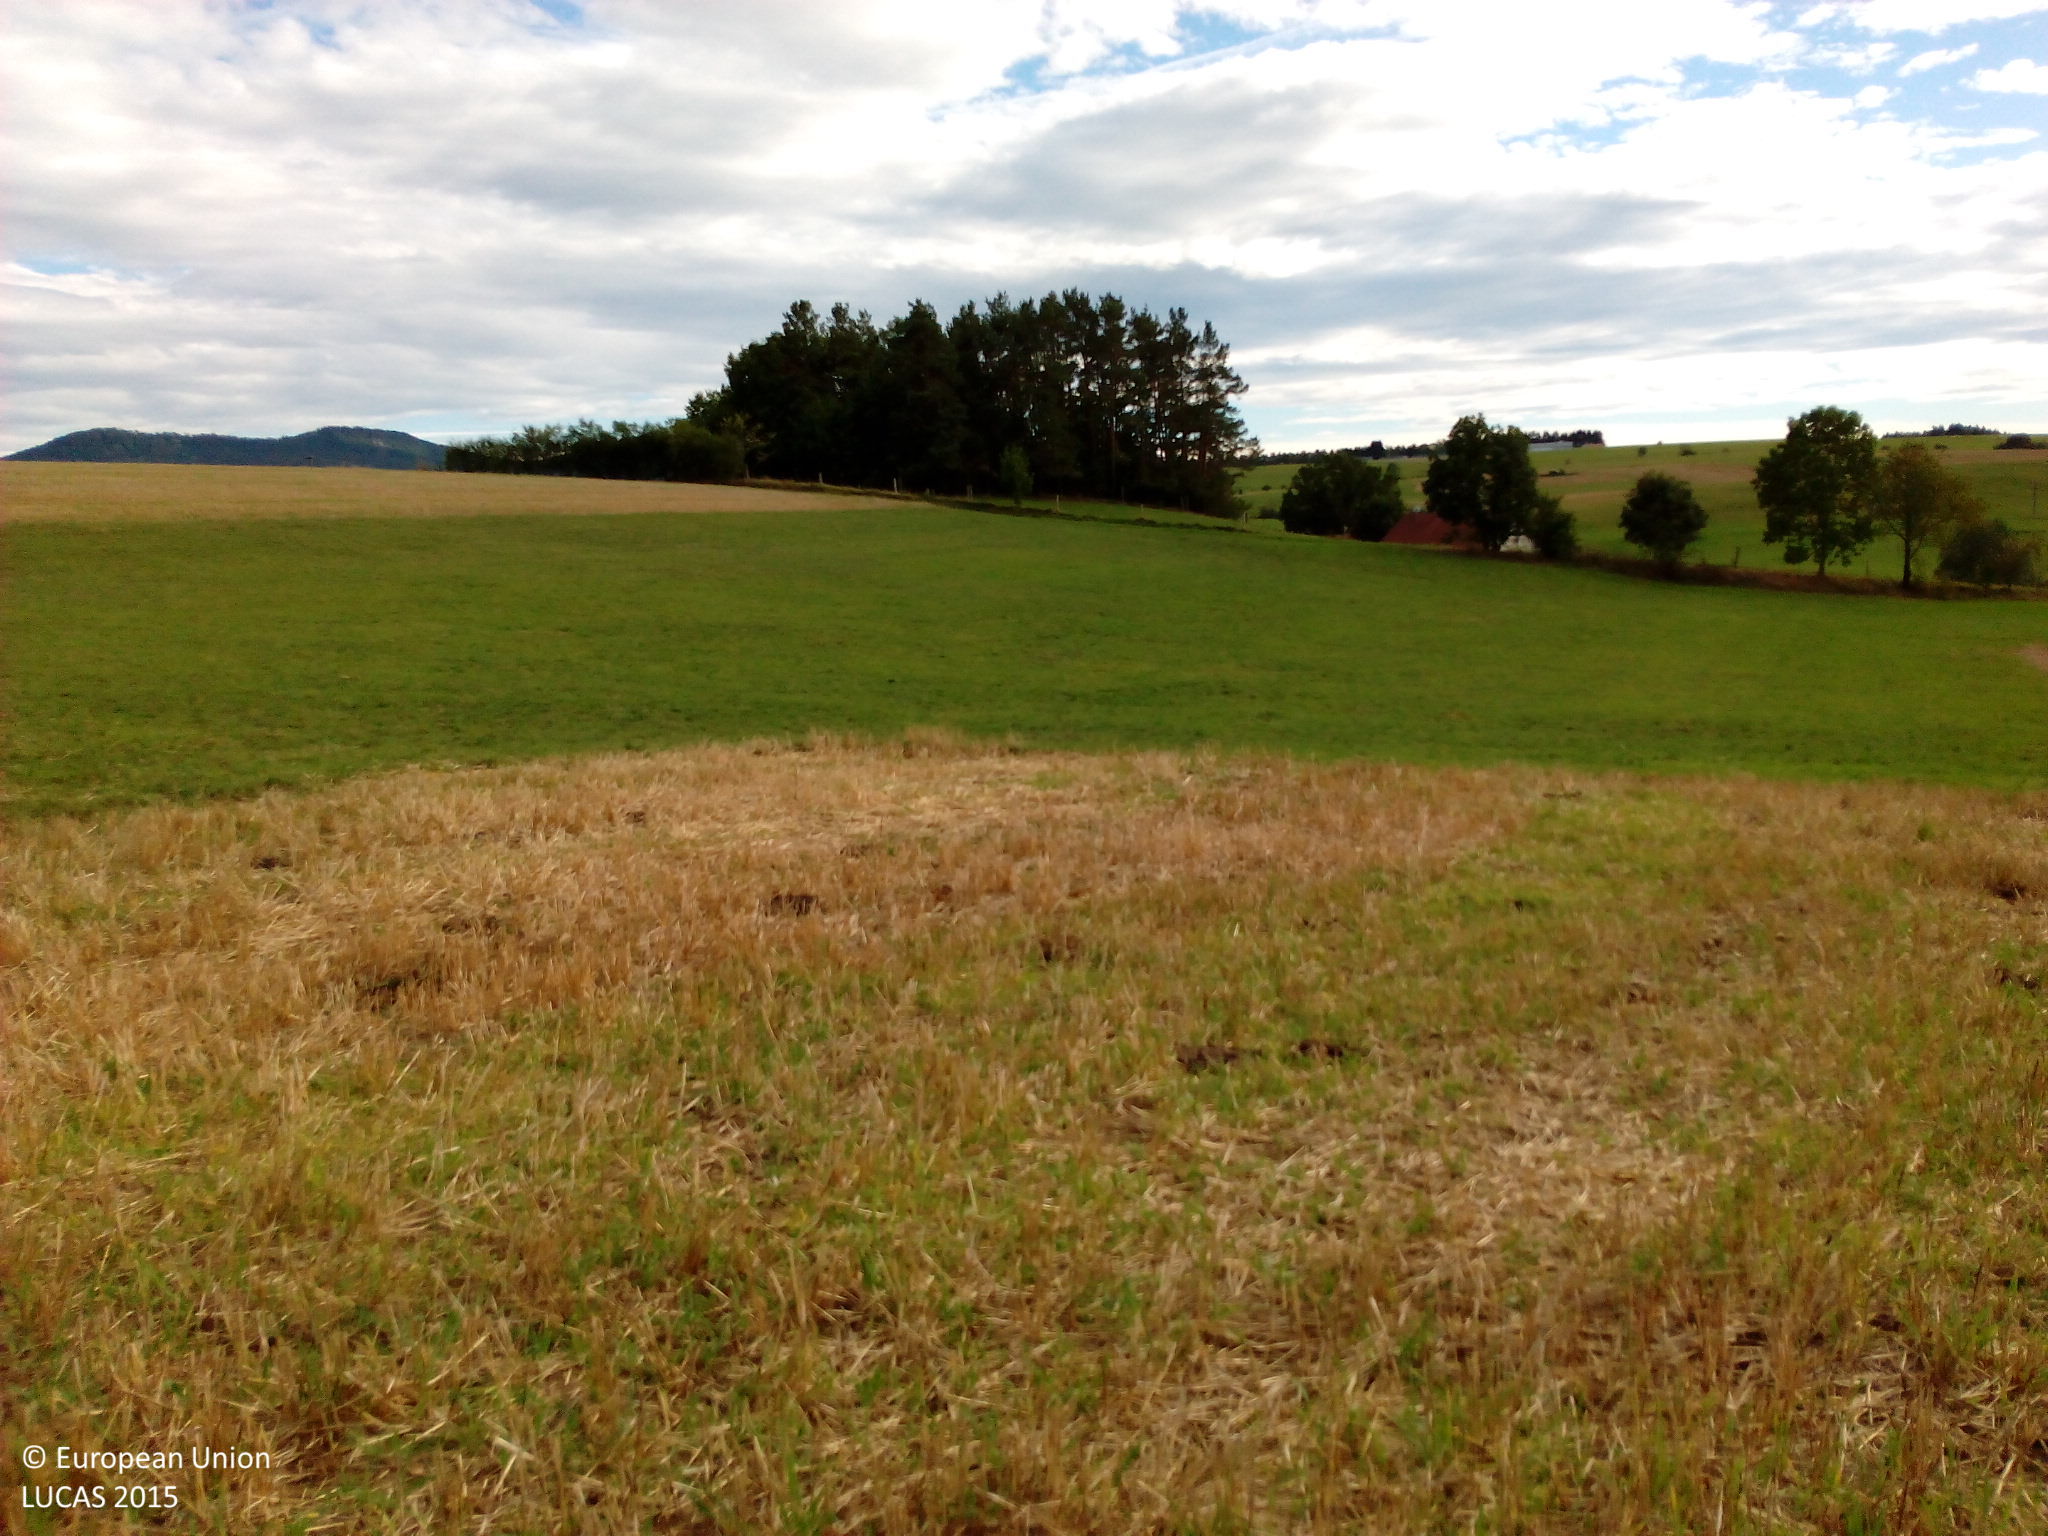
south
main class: Cropland
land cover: Common wheat
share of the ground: 10 - 25 %
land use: Agriculture (excluding fallow land and kitchen gardens)
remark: Harvested field
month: September
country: DE
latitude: 48.1981
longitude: 8.7226
